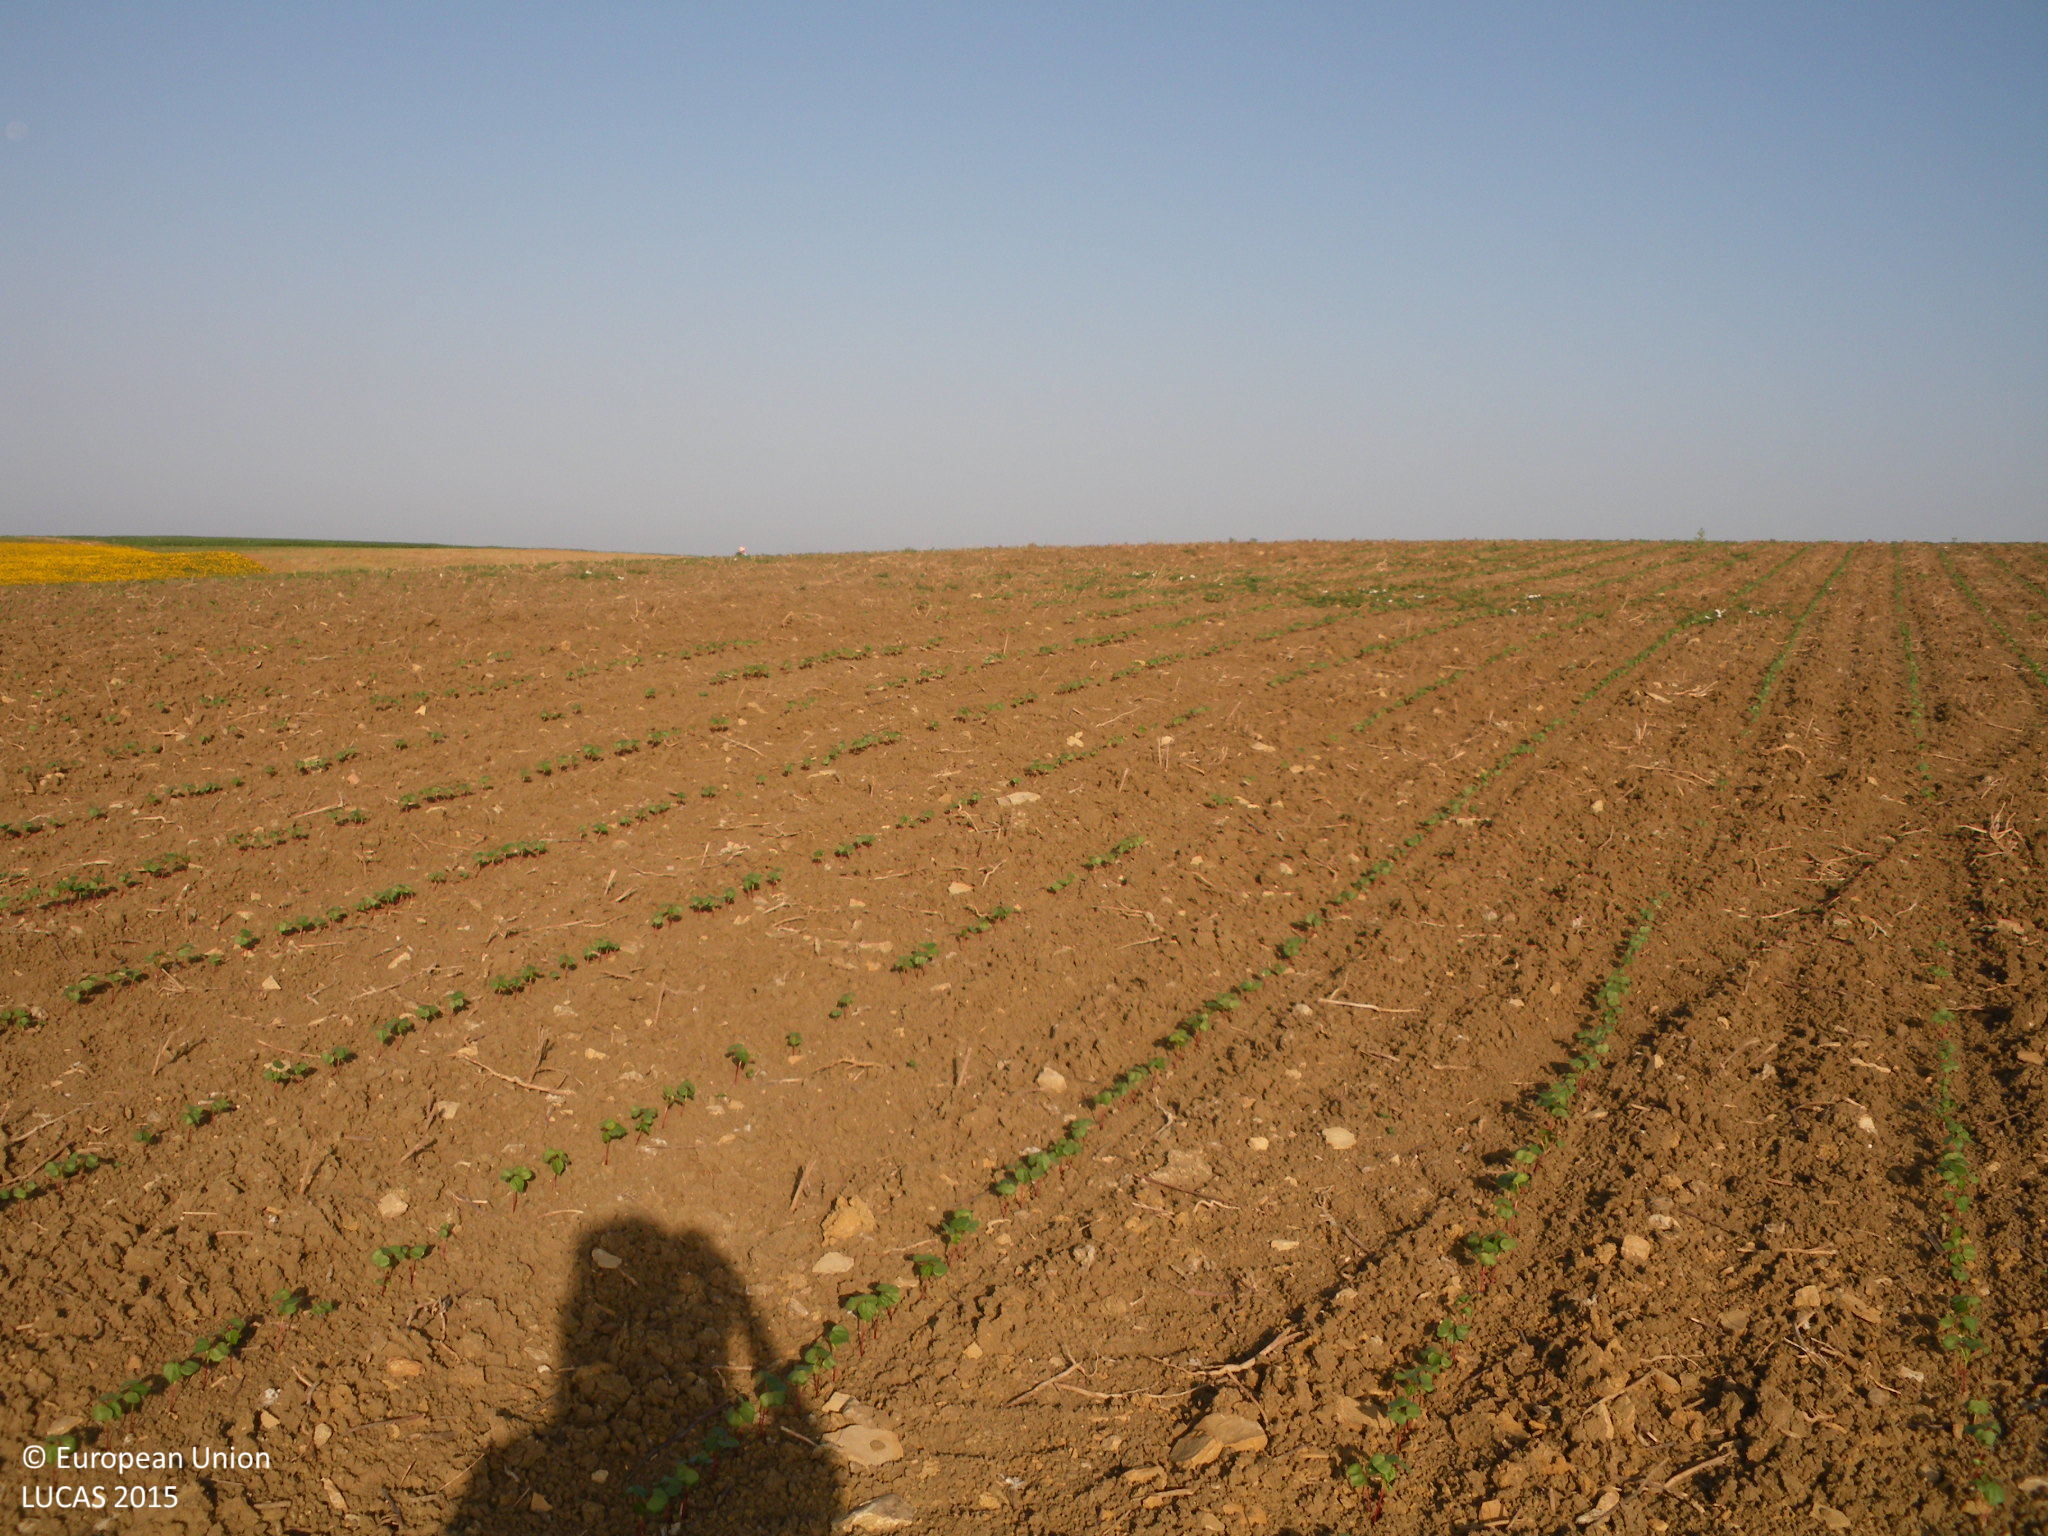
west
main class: Cropland
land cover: Cotton
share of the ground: < 10 %
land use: Agriculture (excluding fallow land and kitchen gardens)
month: June
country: ES
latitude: 36.6466
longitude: -6.2888
